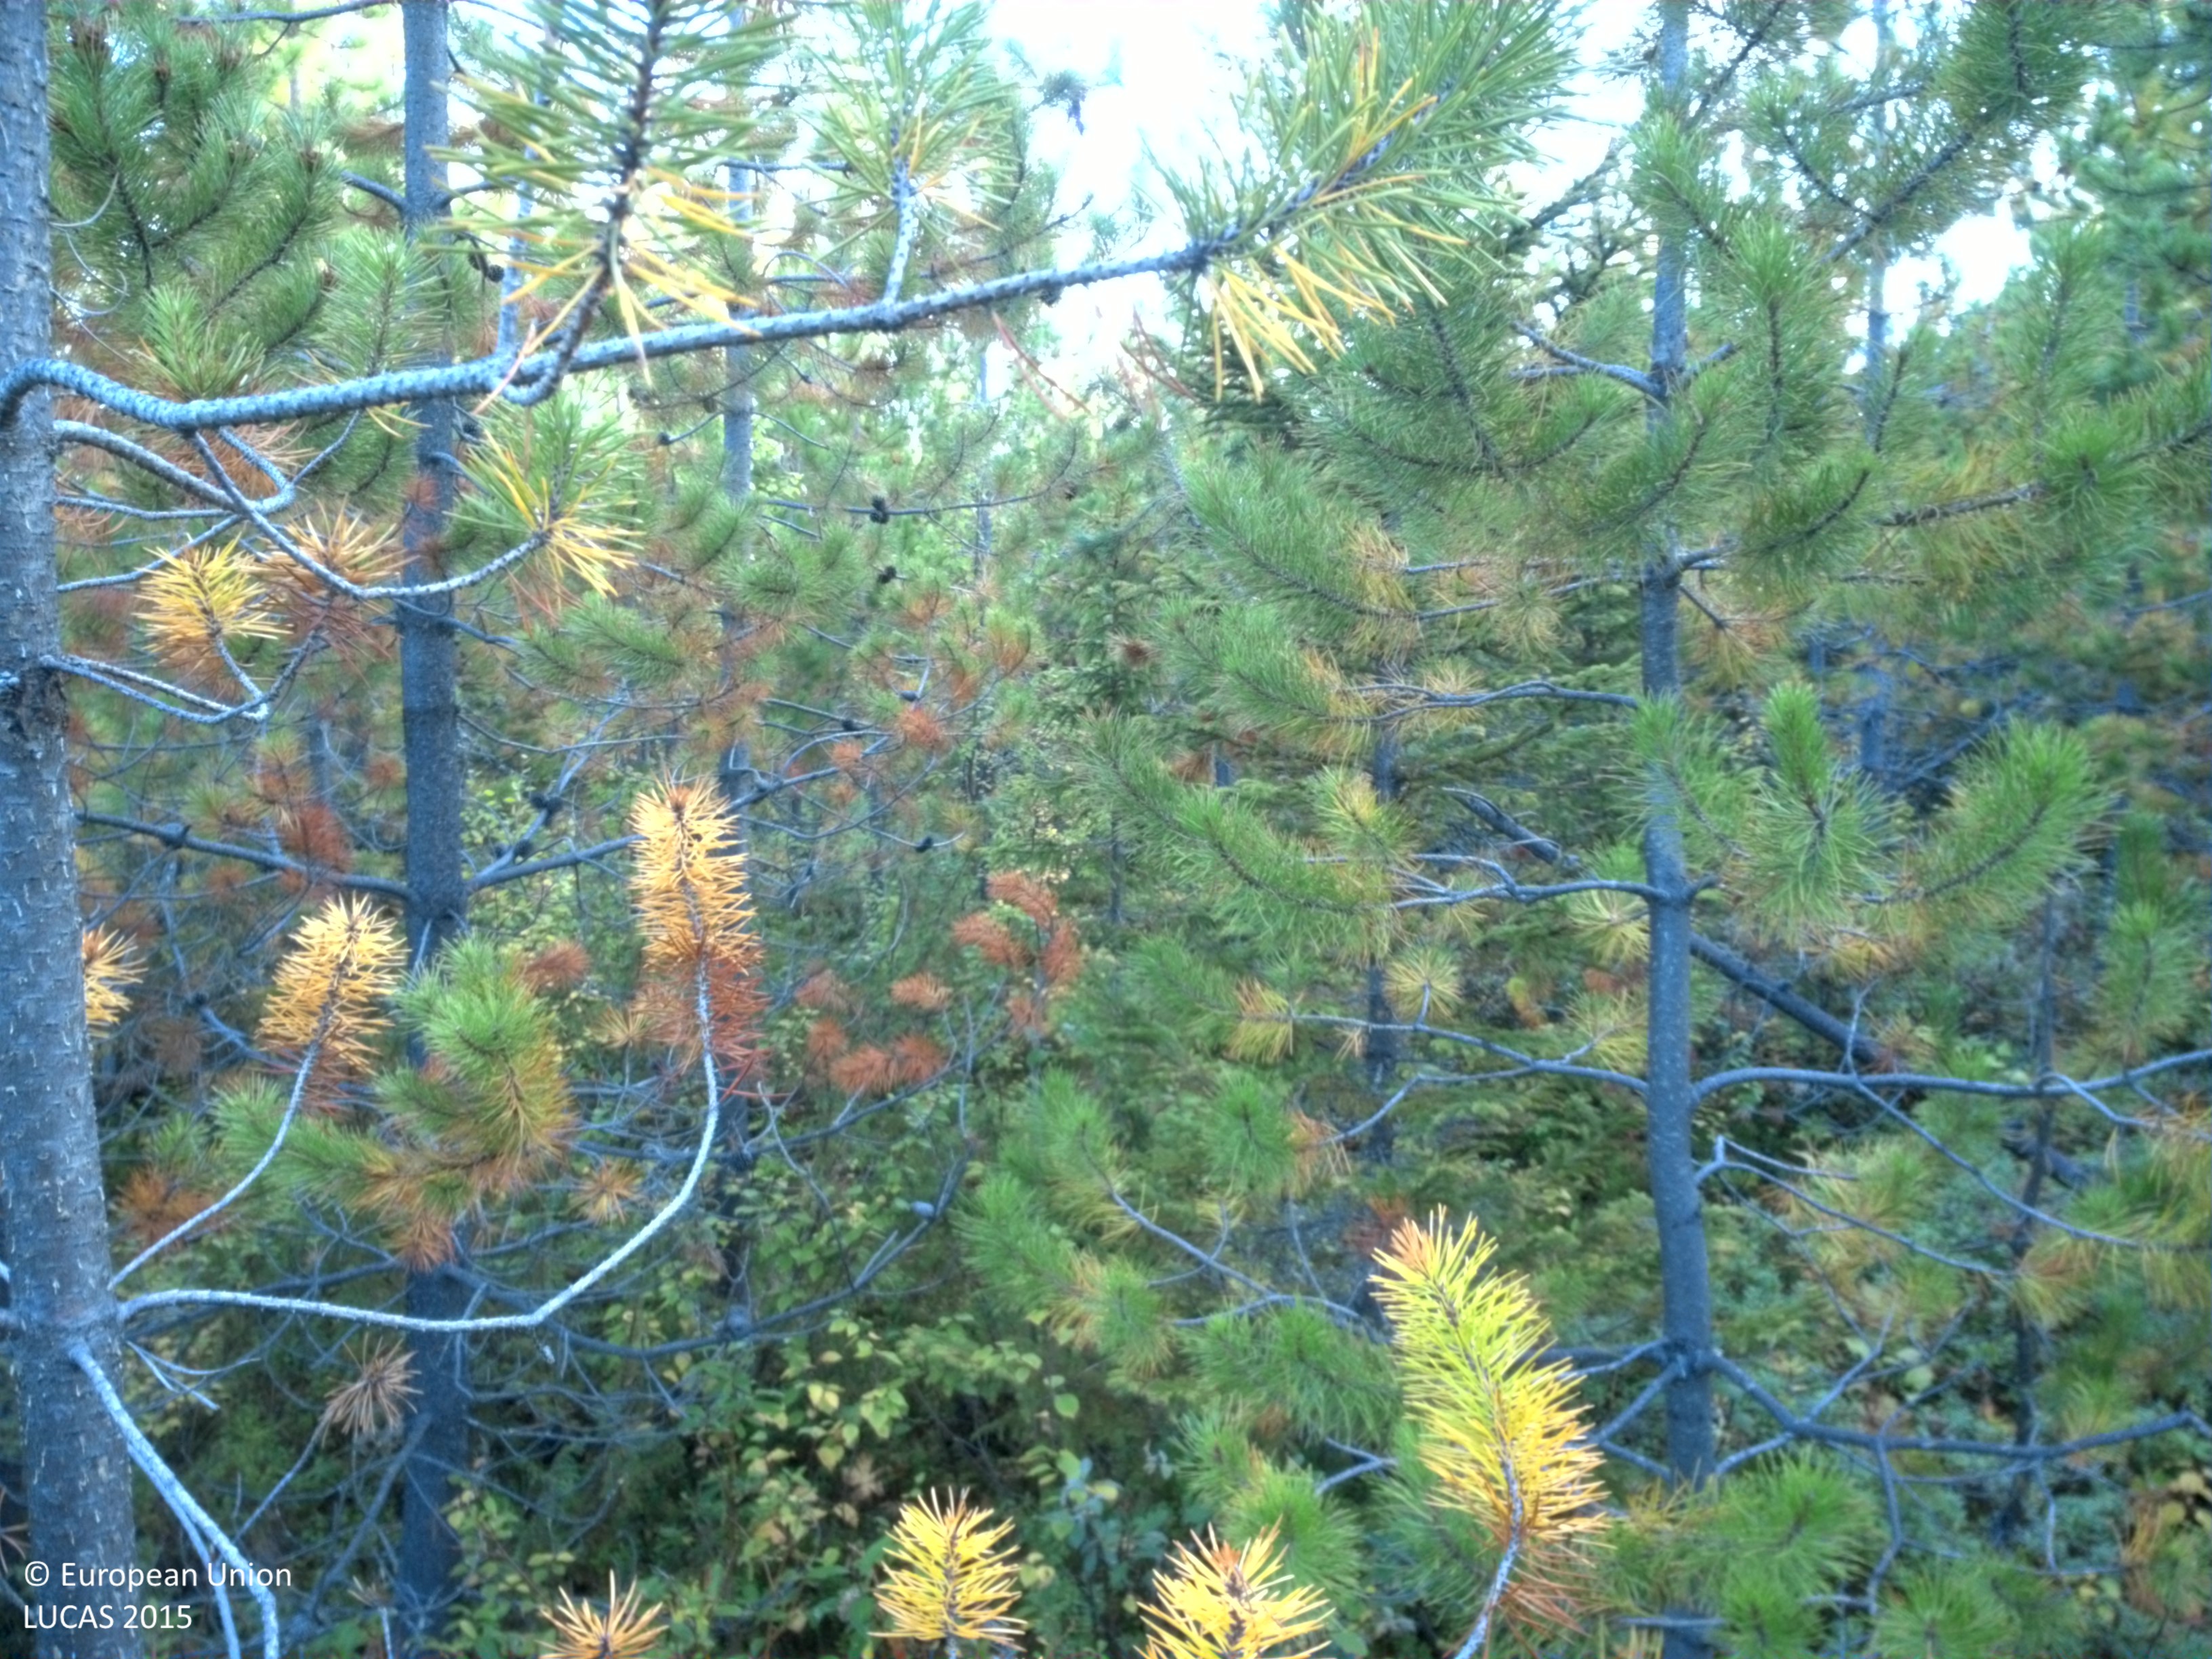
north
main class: Woodland
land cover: Pine dominated coniferous woodland
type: exotic forest
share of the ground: > 75 %
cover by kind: coniferous forest trees 75 %, shrubs 15 %, broadleaved forest trees 5 %, herbaceous plants 5 %
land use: Forestry
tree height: > 5 m
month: September
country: SE
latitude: 65.1773
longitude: 17.6262
